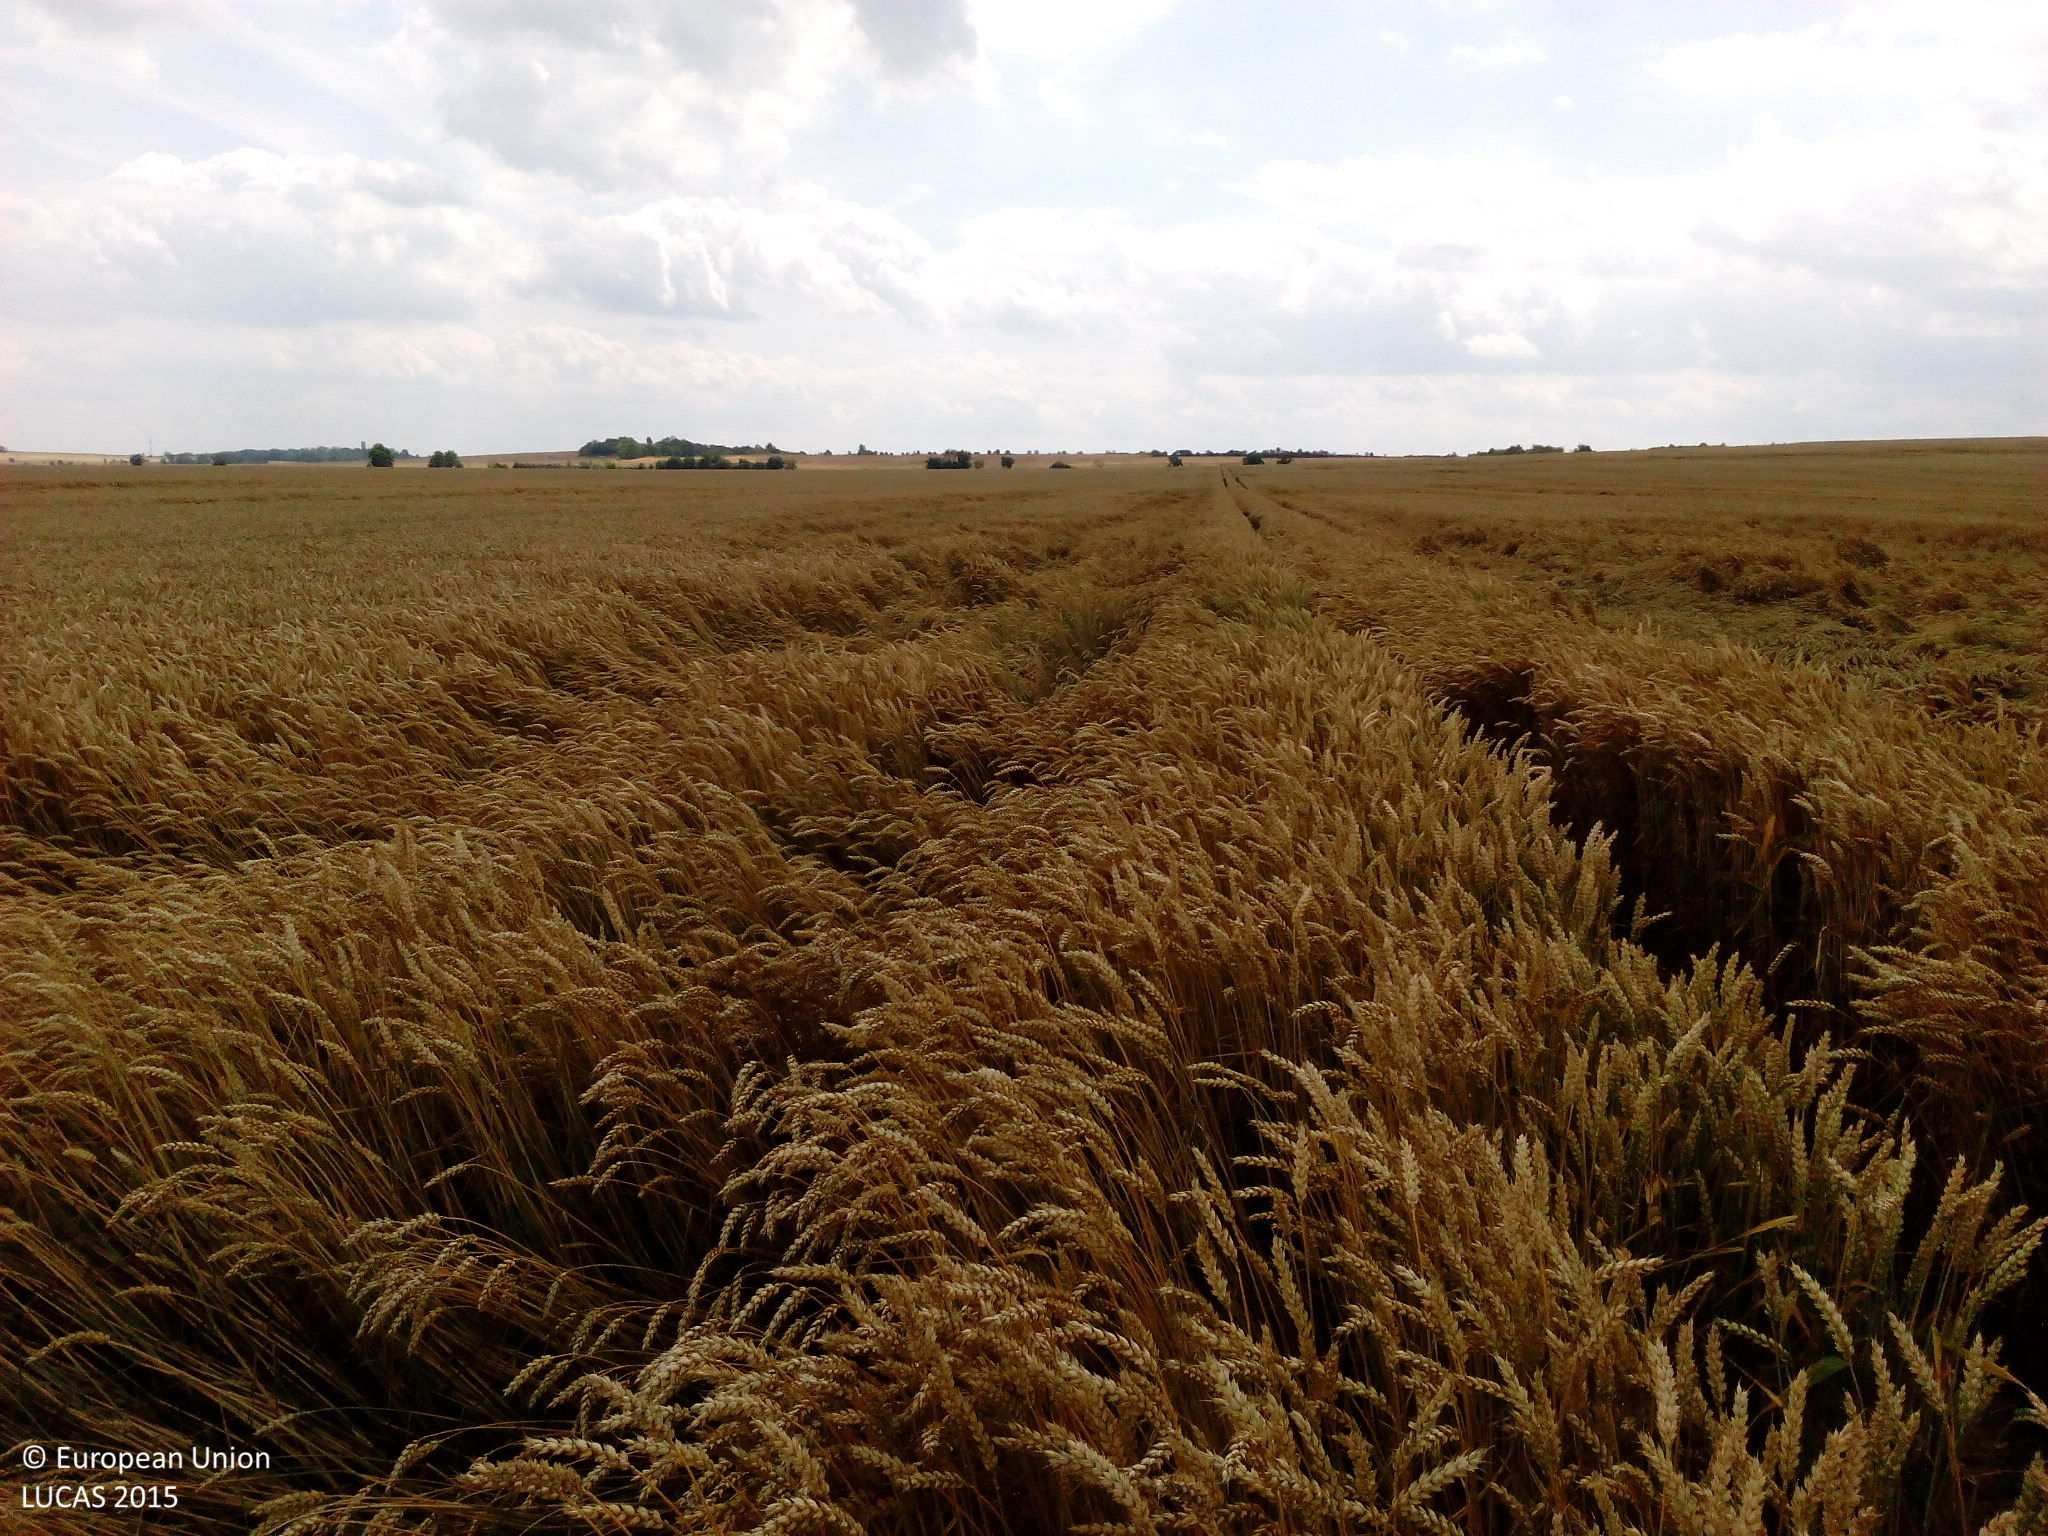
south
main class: Cropland
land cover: Common wheat
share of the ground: > 75 %
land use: Agriculture (excluding fallow land and kitchen gardens)
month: July
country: DE
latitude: 51.9518
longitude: 11.7020
